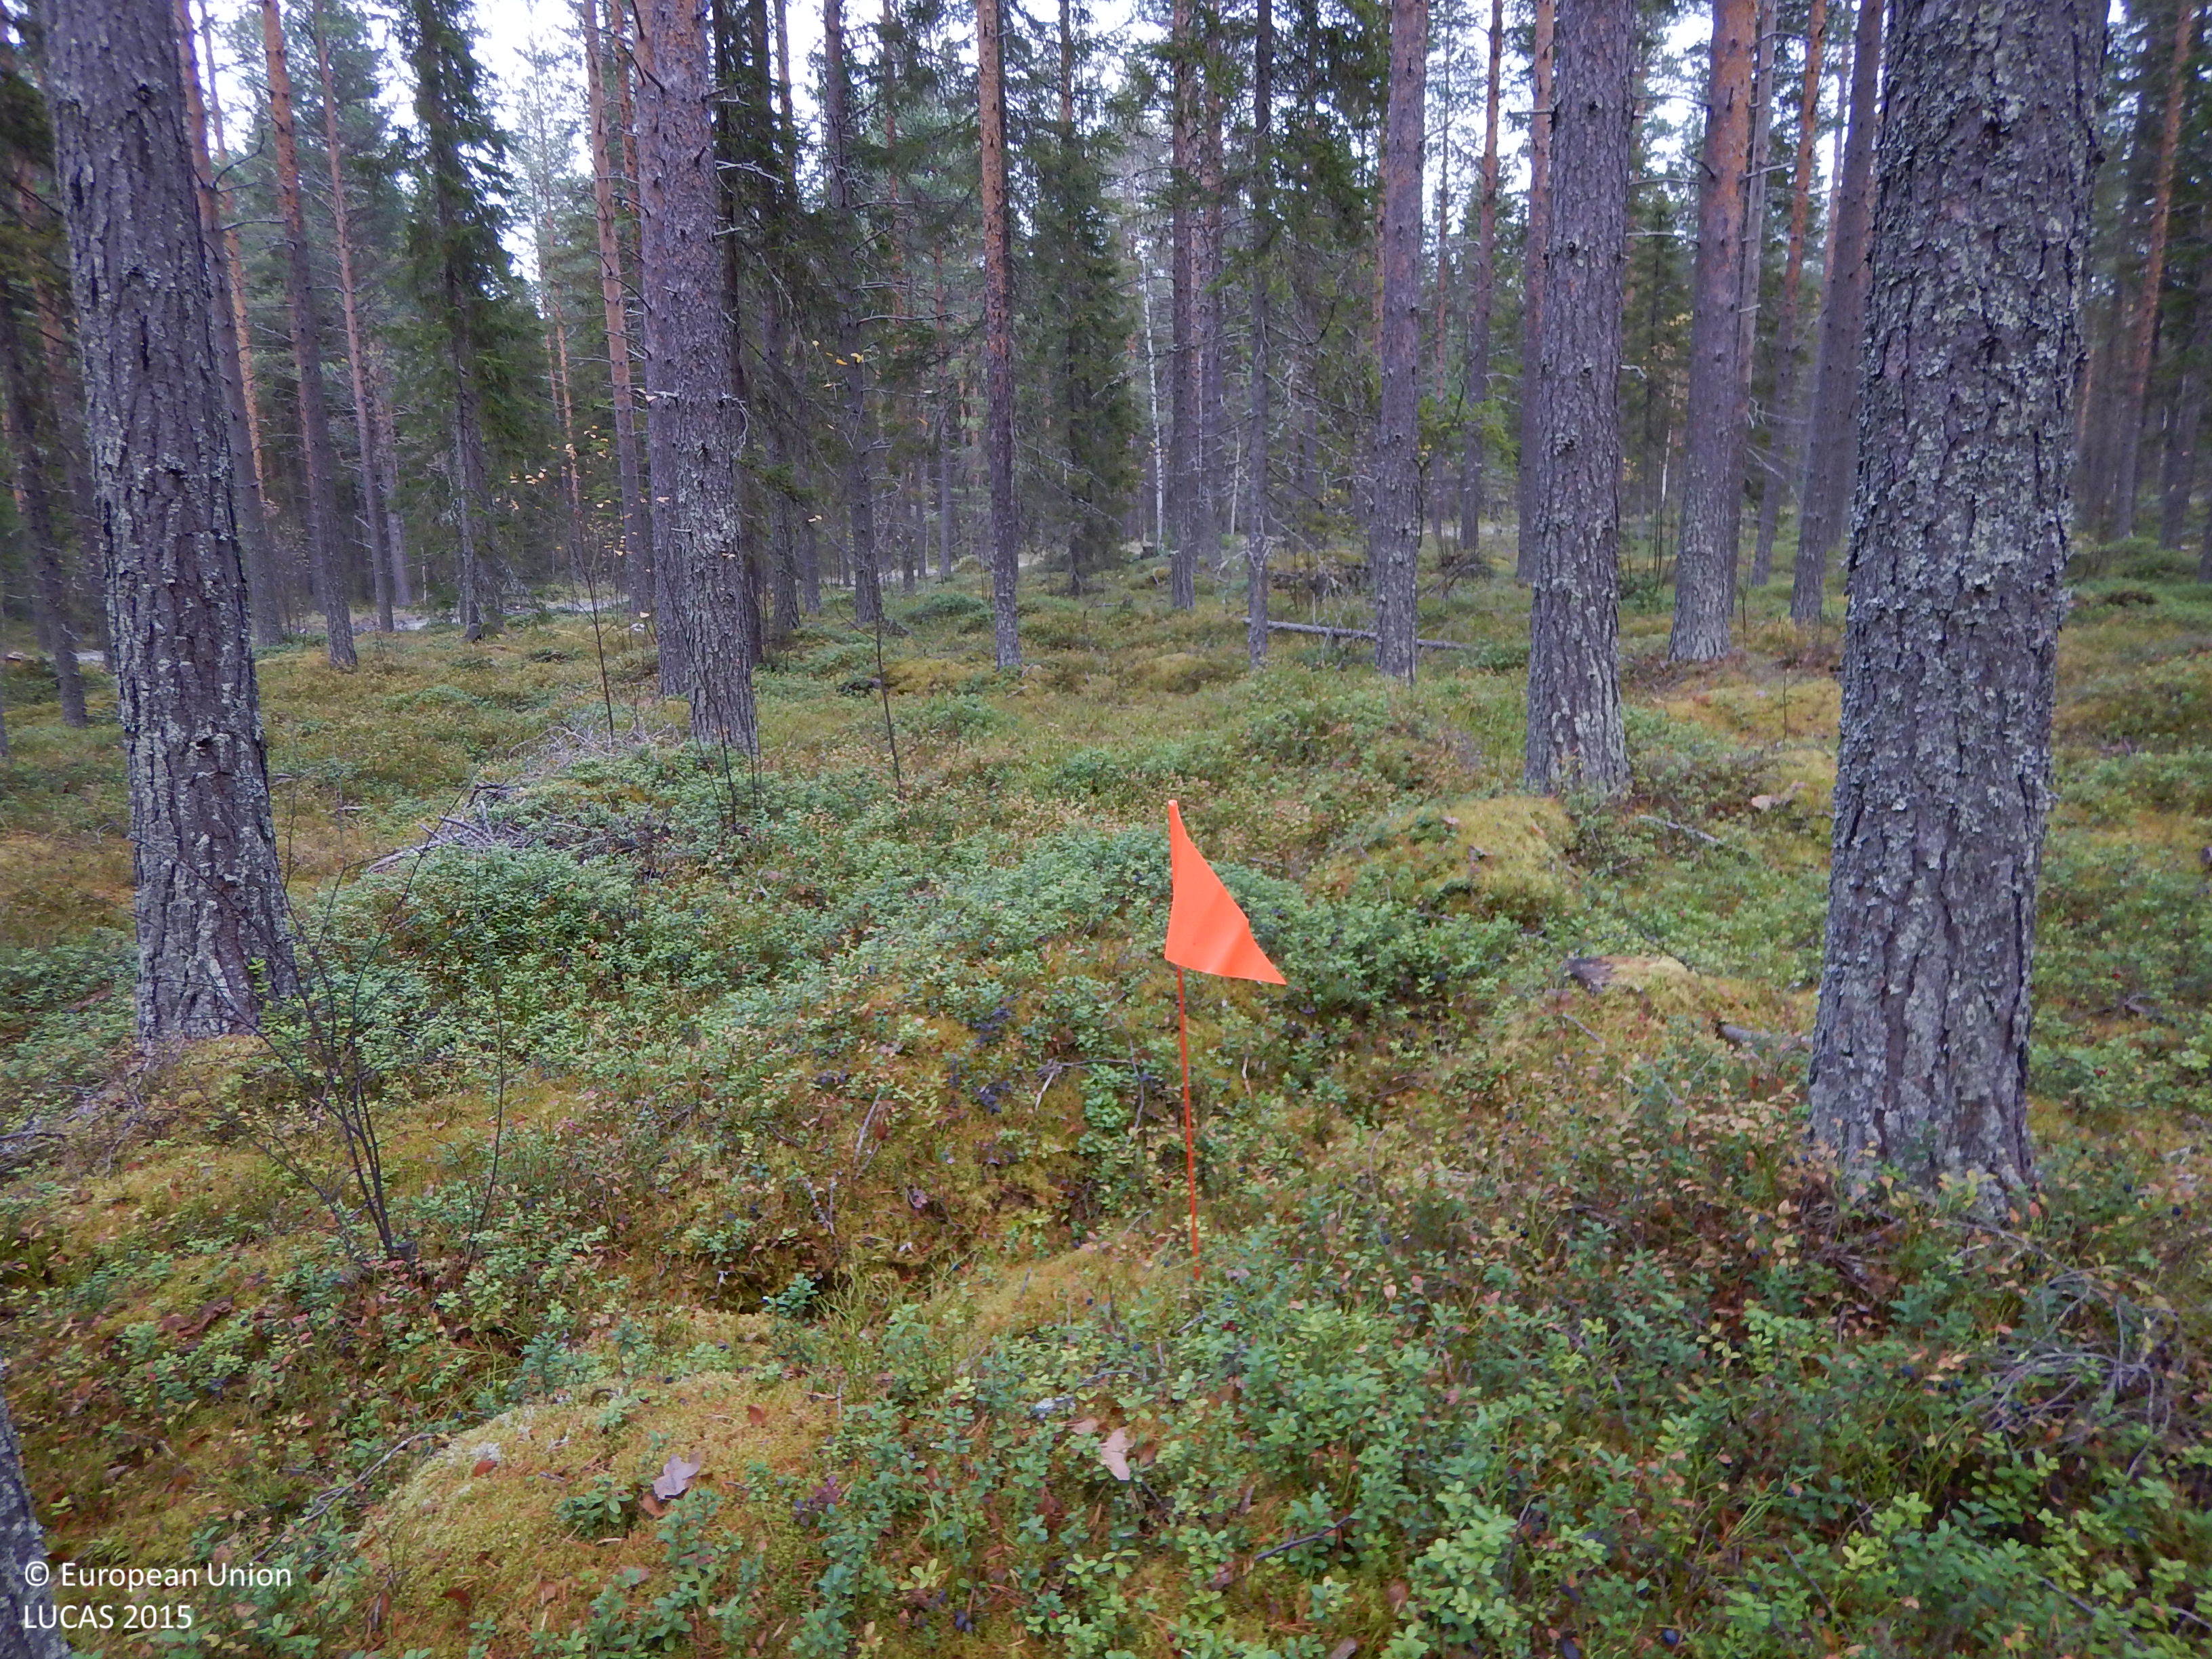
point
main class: Woodland
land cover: Pine dominated coniferous woodland
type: boreal forest
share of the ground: 50 - 75 %
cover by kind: coniferous forest trees 60 %, shrubs 20 %, lichens and mosses 10 %, broadleaved forest trees 5 %, herbaceous plants 5 %
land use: Forestry
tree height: > 5 m
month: October
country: SE
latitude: 65.1217
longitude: 21.1171
